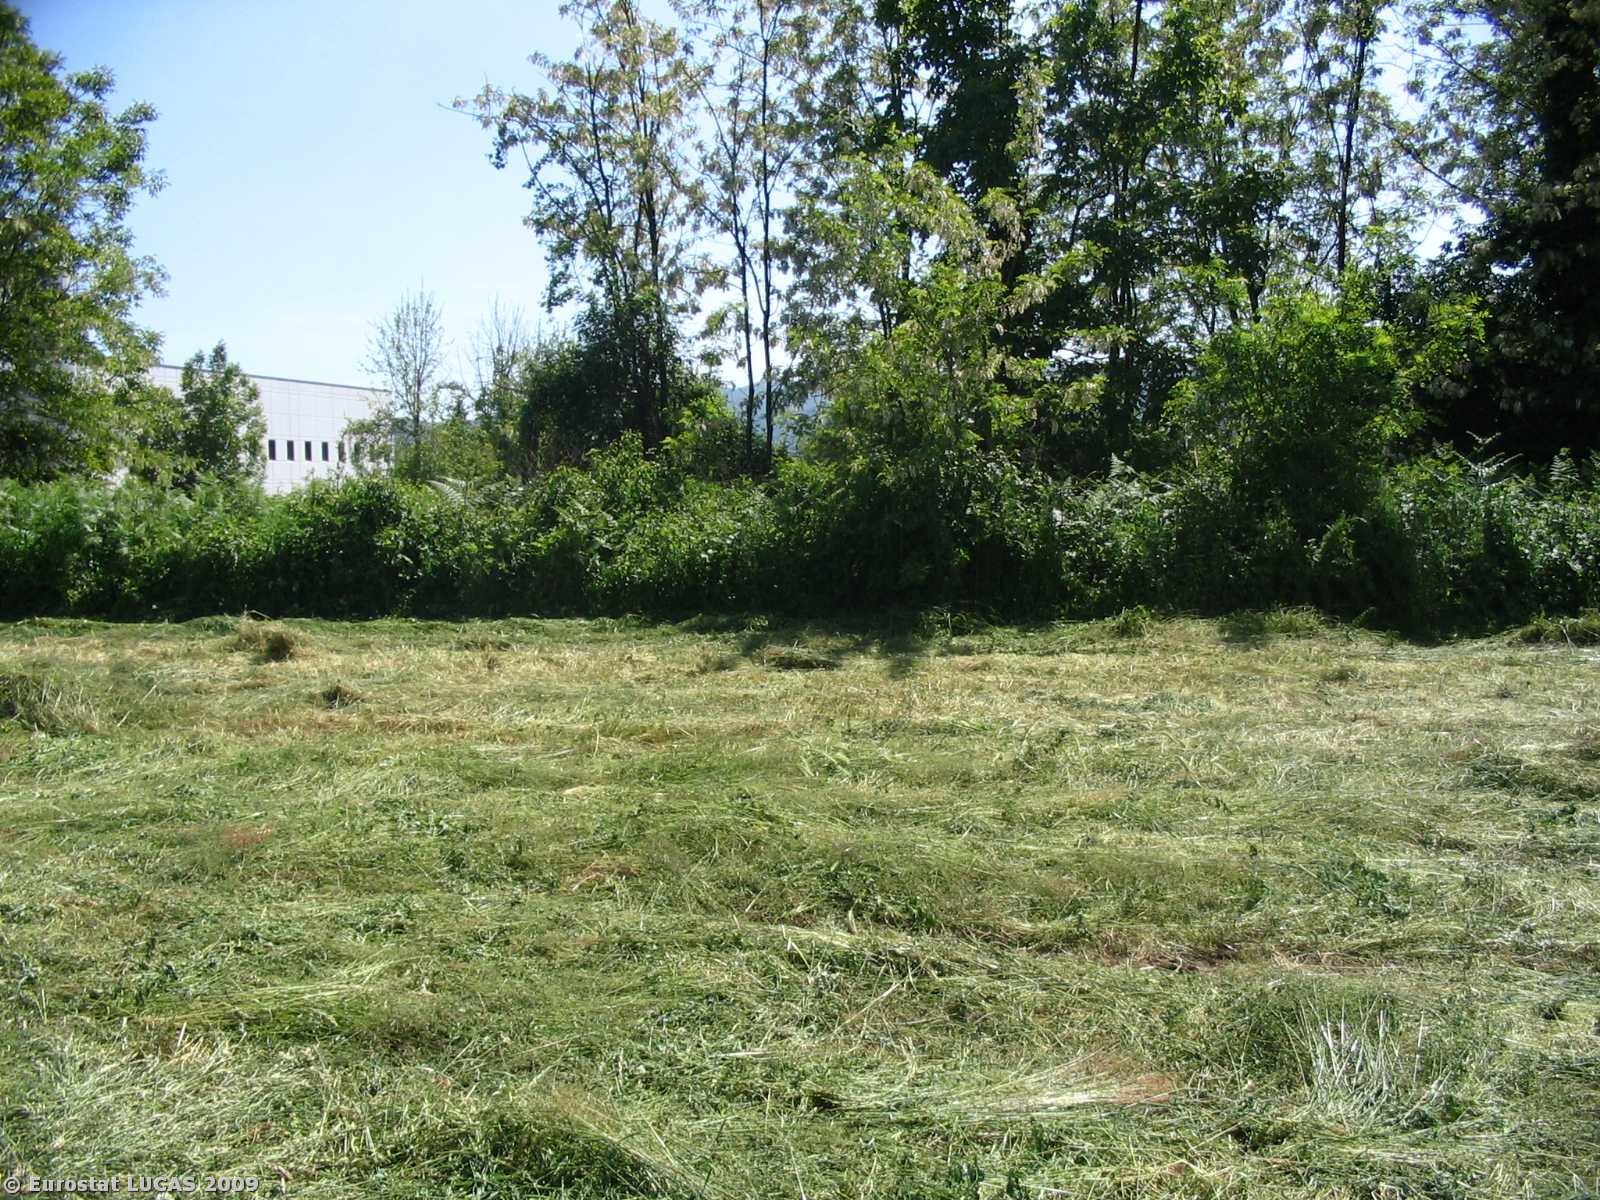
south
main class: Cropland
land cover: Lucerne
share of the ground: < 10 %
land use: Agriculture (excluding fallow land and kitchen gardens)
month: May
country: IT
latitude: 41.2943
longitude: 14.3423
